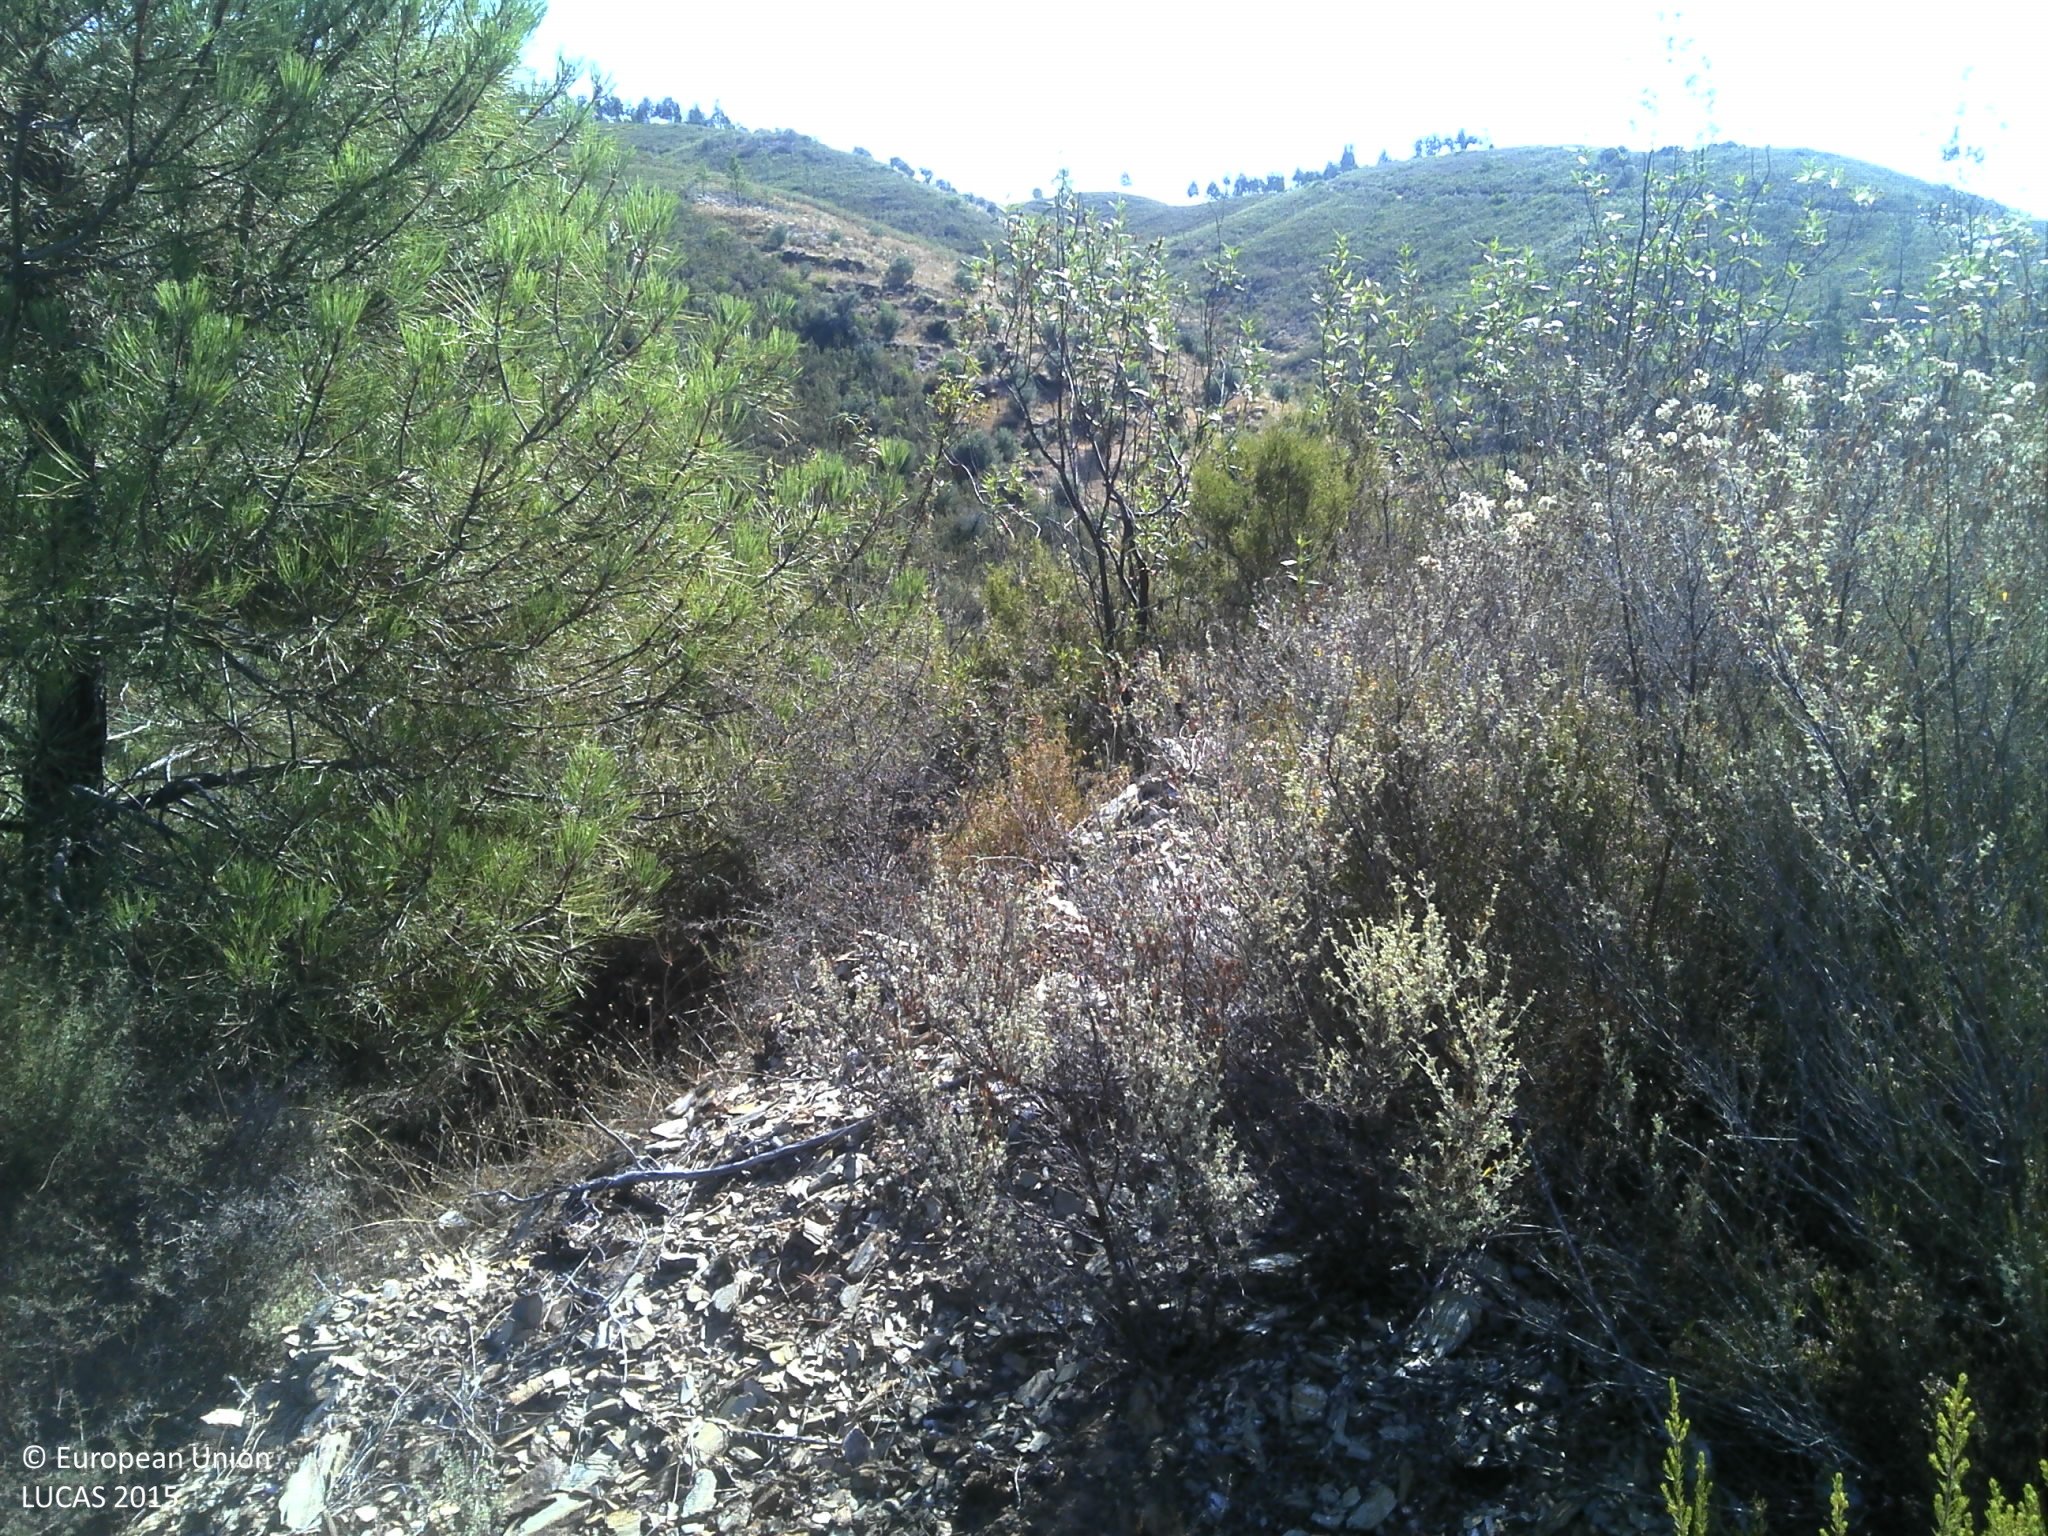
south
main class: Shrubland
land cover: Shrubland with sparse tree cover
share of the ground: 50 - 75 %
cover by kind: shrubs 75 %, unconsolidated bare surface 10 %, coniferous forest trees 5 %, herbaceous plants 5 %
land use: Forestry
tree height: < 5 m
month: July
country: PT
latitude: 39.8226
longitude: -7.6150
